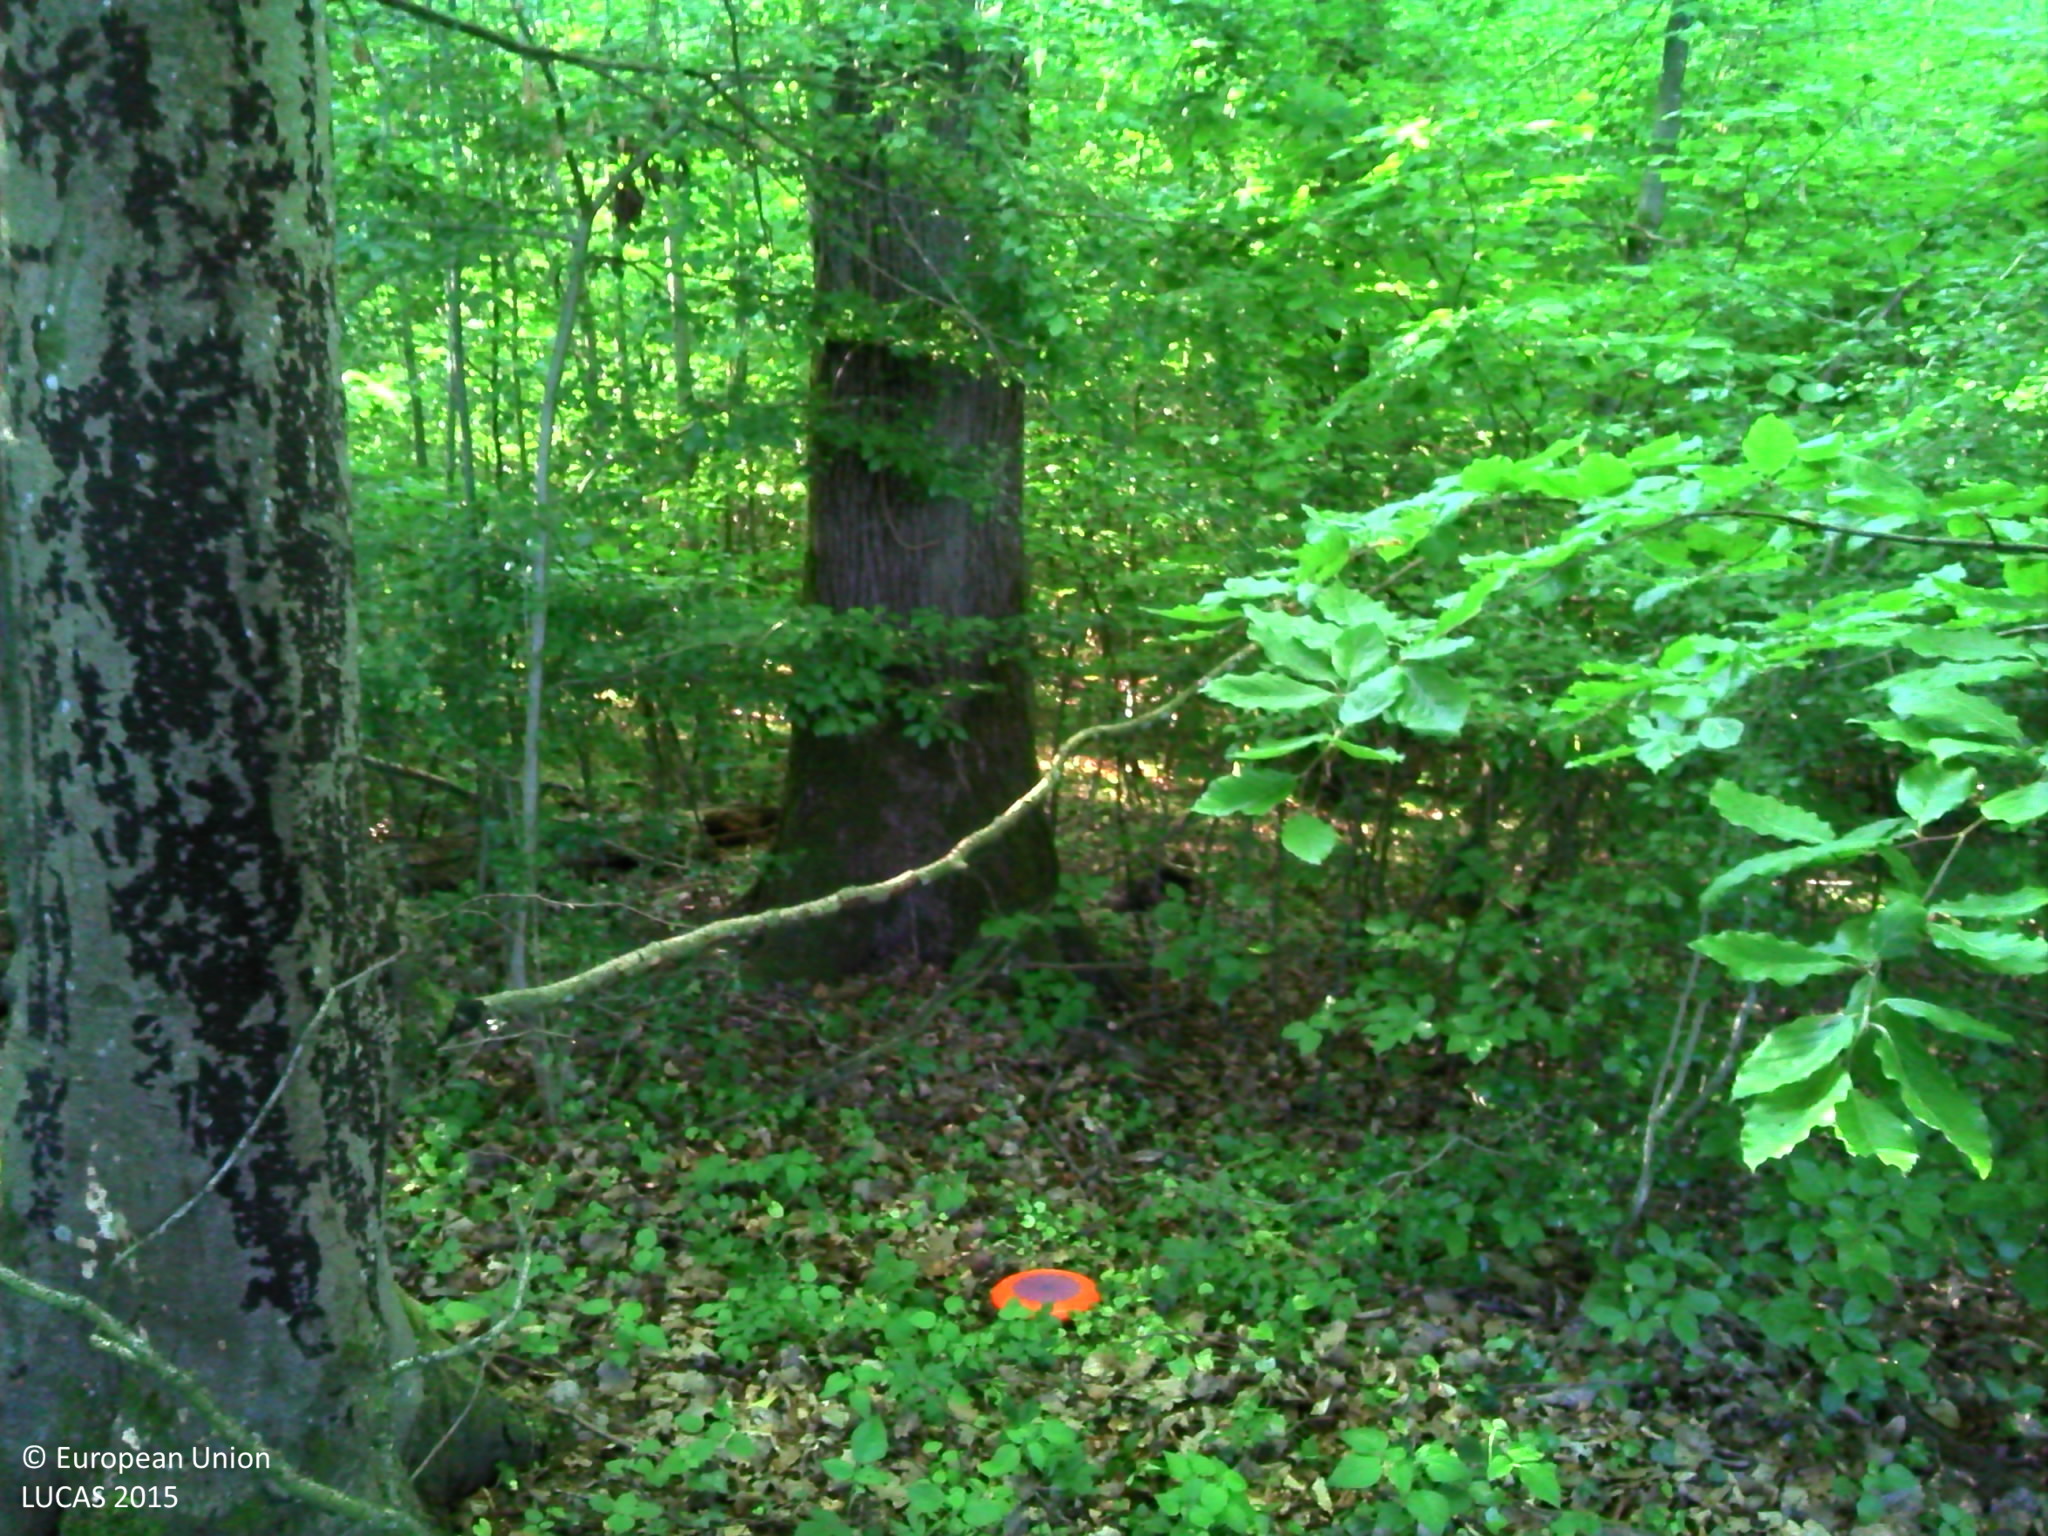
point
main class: Woodland
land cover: Broadleaved woodland
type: mesophytic deciduous forest
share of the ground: > 75 %
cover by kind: broadleaved forest trees 90 %, herbaceous plants 5 %, lichens and mosses 5 %
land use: Forestry
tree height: > 5 m
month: May
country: LU
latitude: 49.6409
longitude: 6.3854
